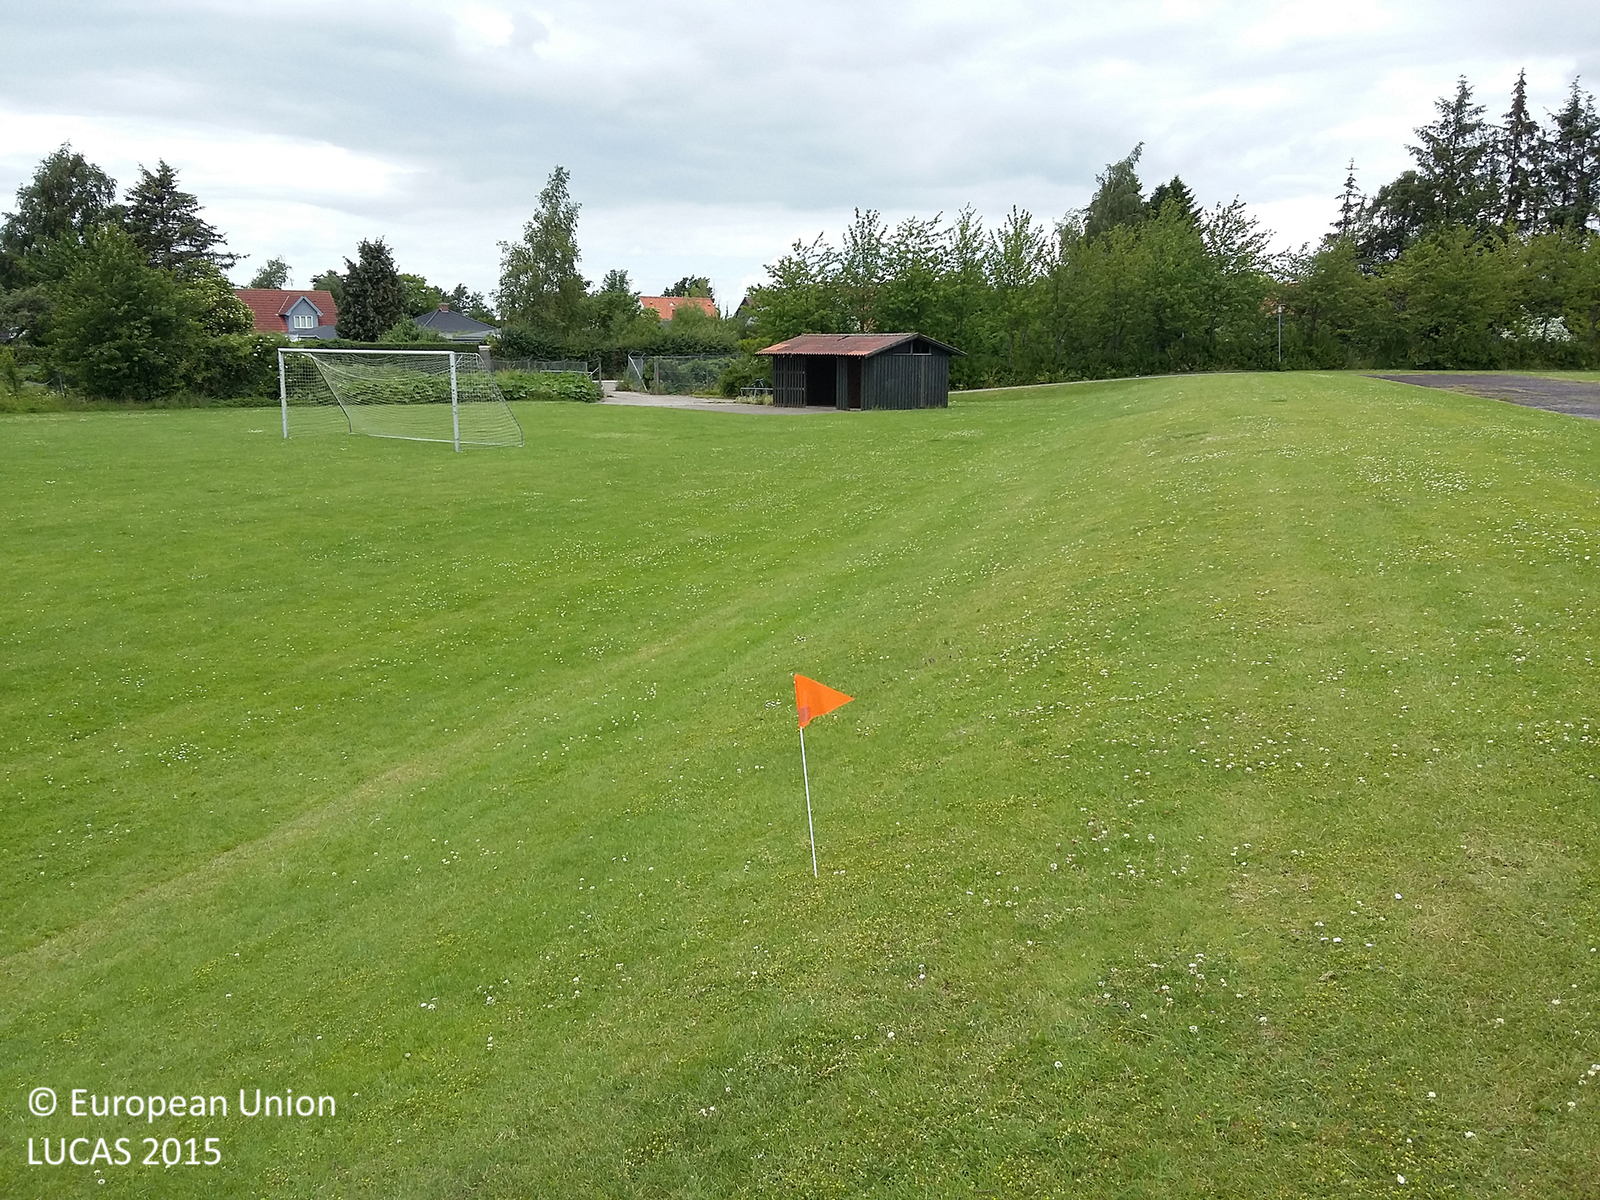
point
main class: Grassland
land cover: Grassland without tree/shrub cover
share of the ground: > 75 %
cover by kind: herbaceous plants 100 %
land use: Sport
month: July
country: DK
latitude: 55.2406
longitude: 11.7758
